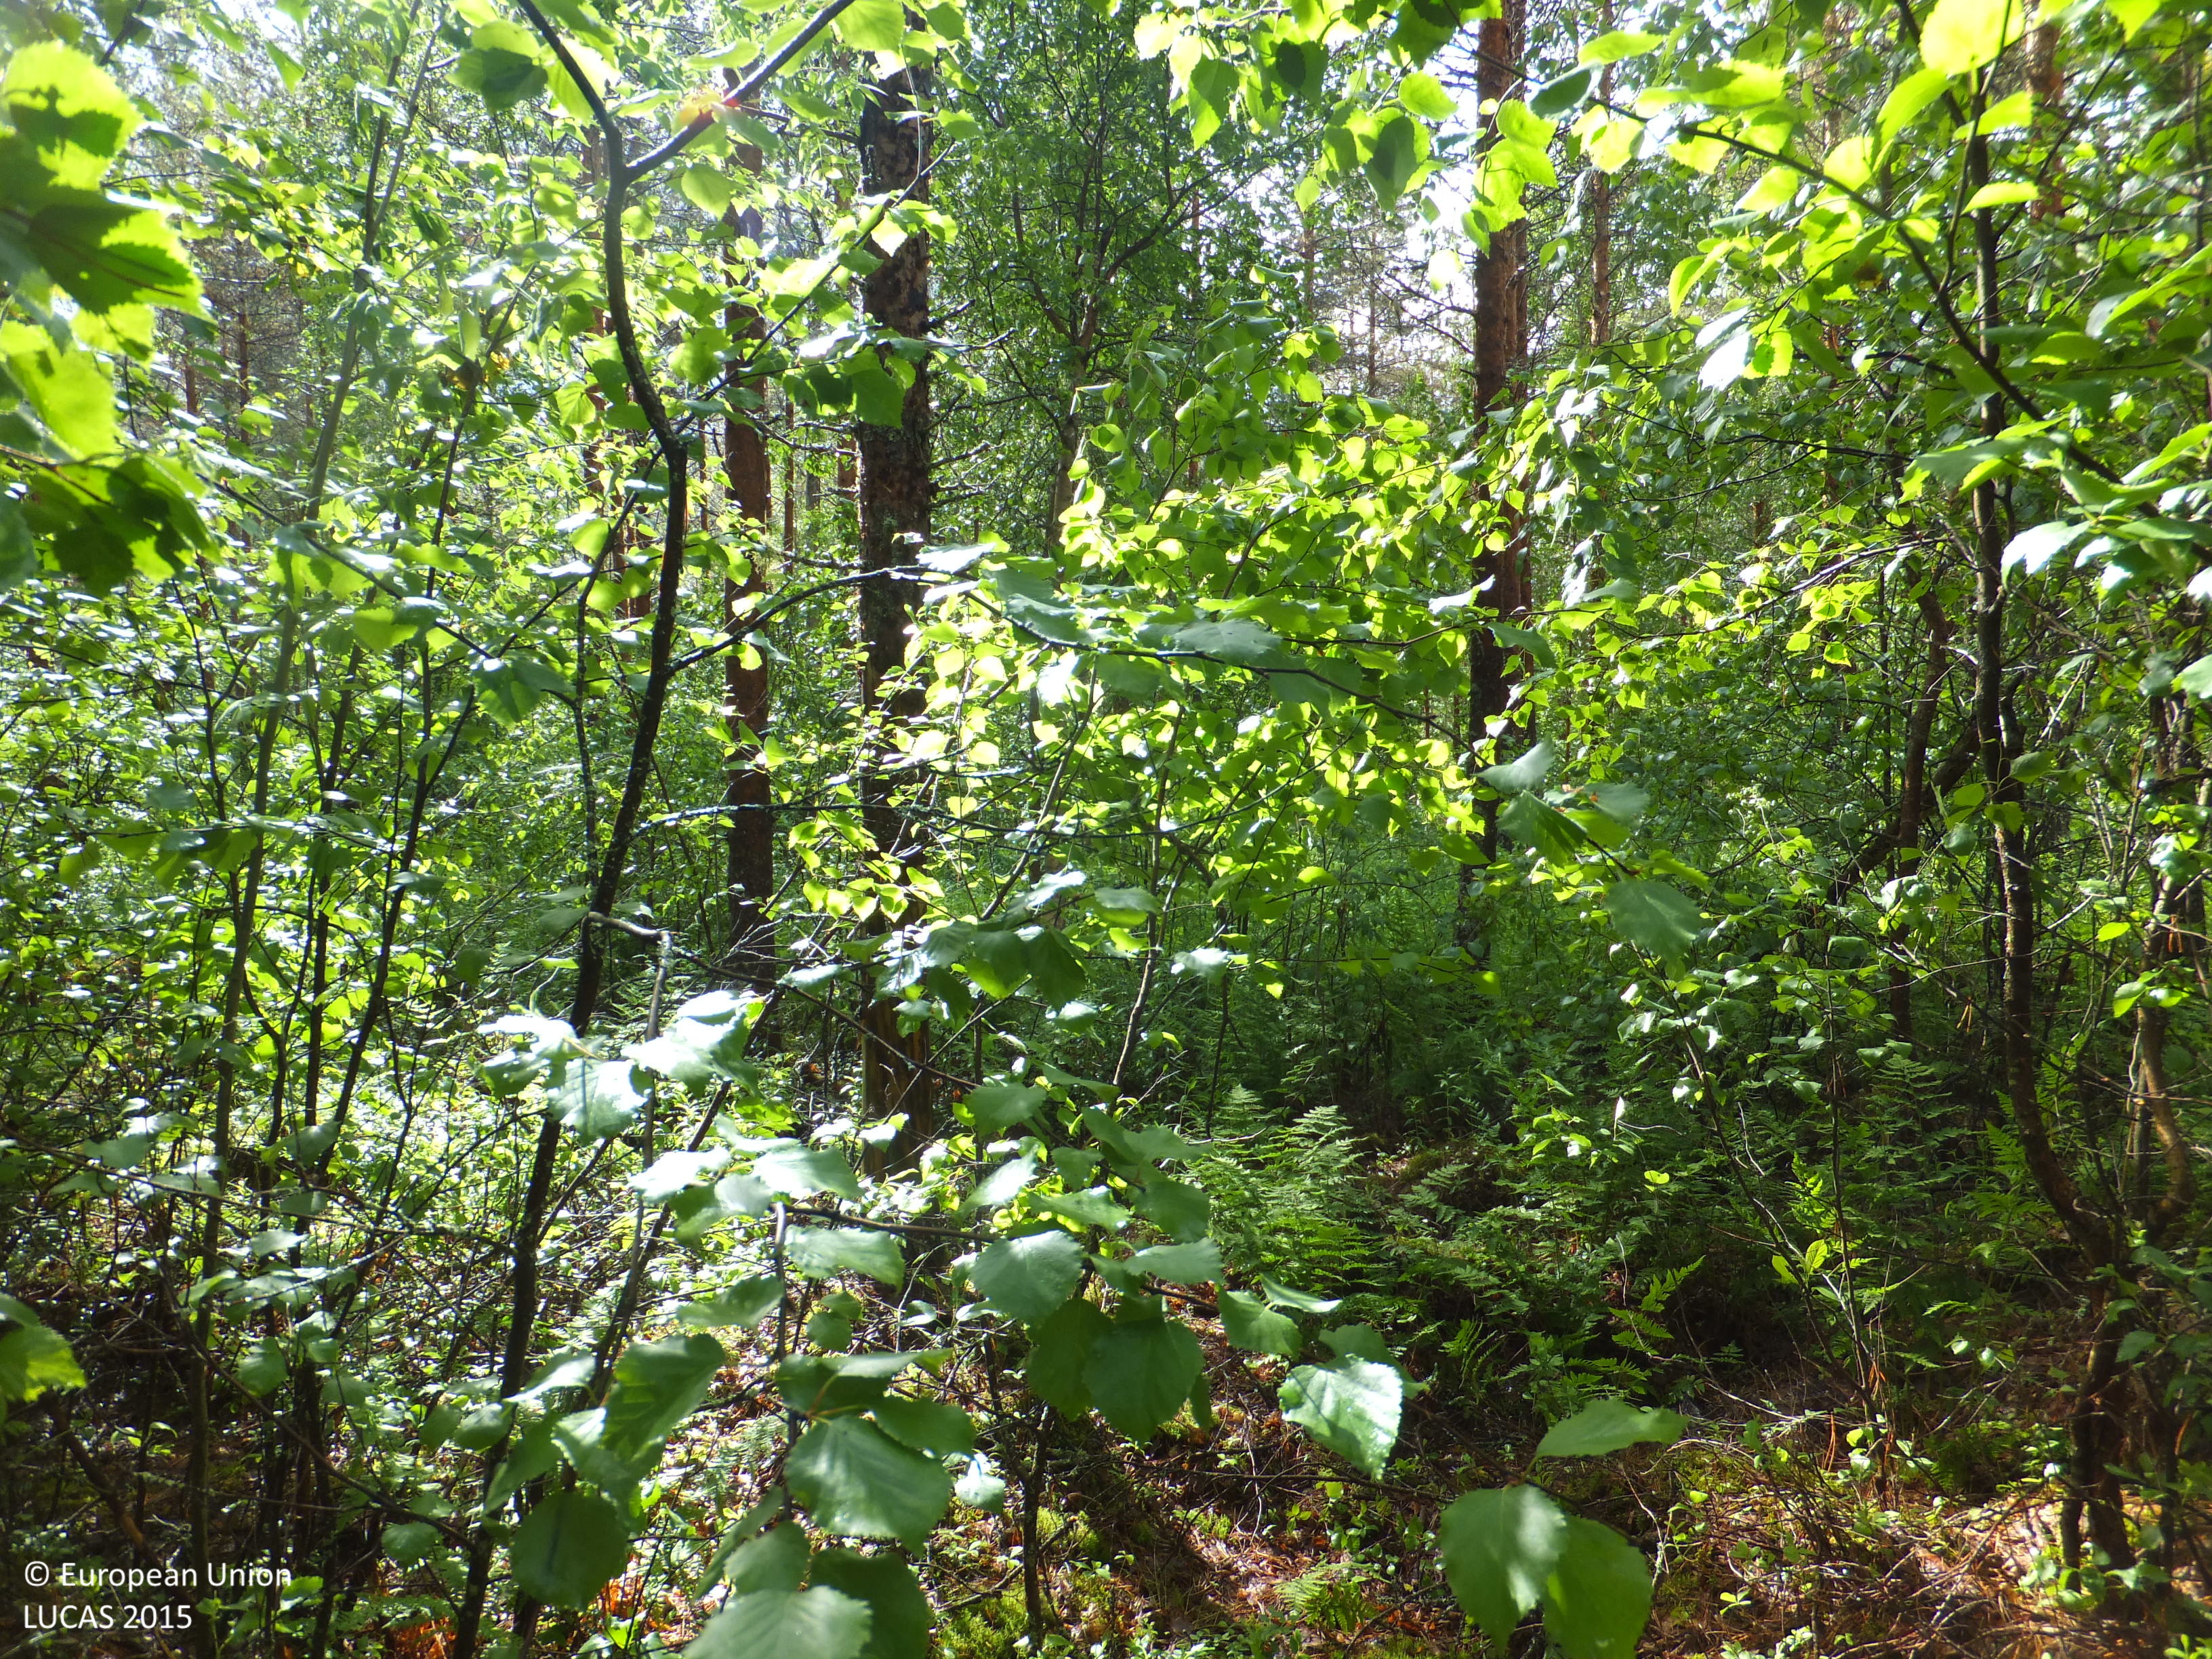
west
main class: Woodland
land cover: Pine dominated mixed woodland
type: boreal forest
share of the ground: > 75 %
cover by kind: coniferous forest trees 45 %, broadleaved forest trees 35 %, herbaceous plants 10 %, shrubs 5 %, lichens and mosses 5 %
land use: Forestry
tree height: > 5 m
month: June
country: FI
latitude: 63.4212
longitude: 24.8111
